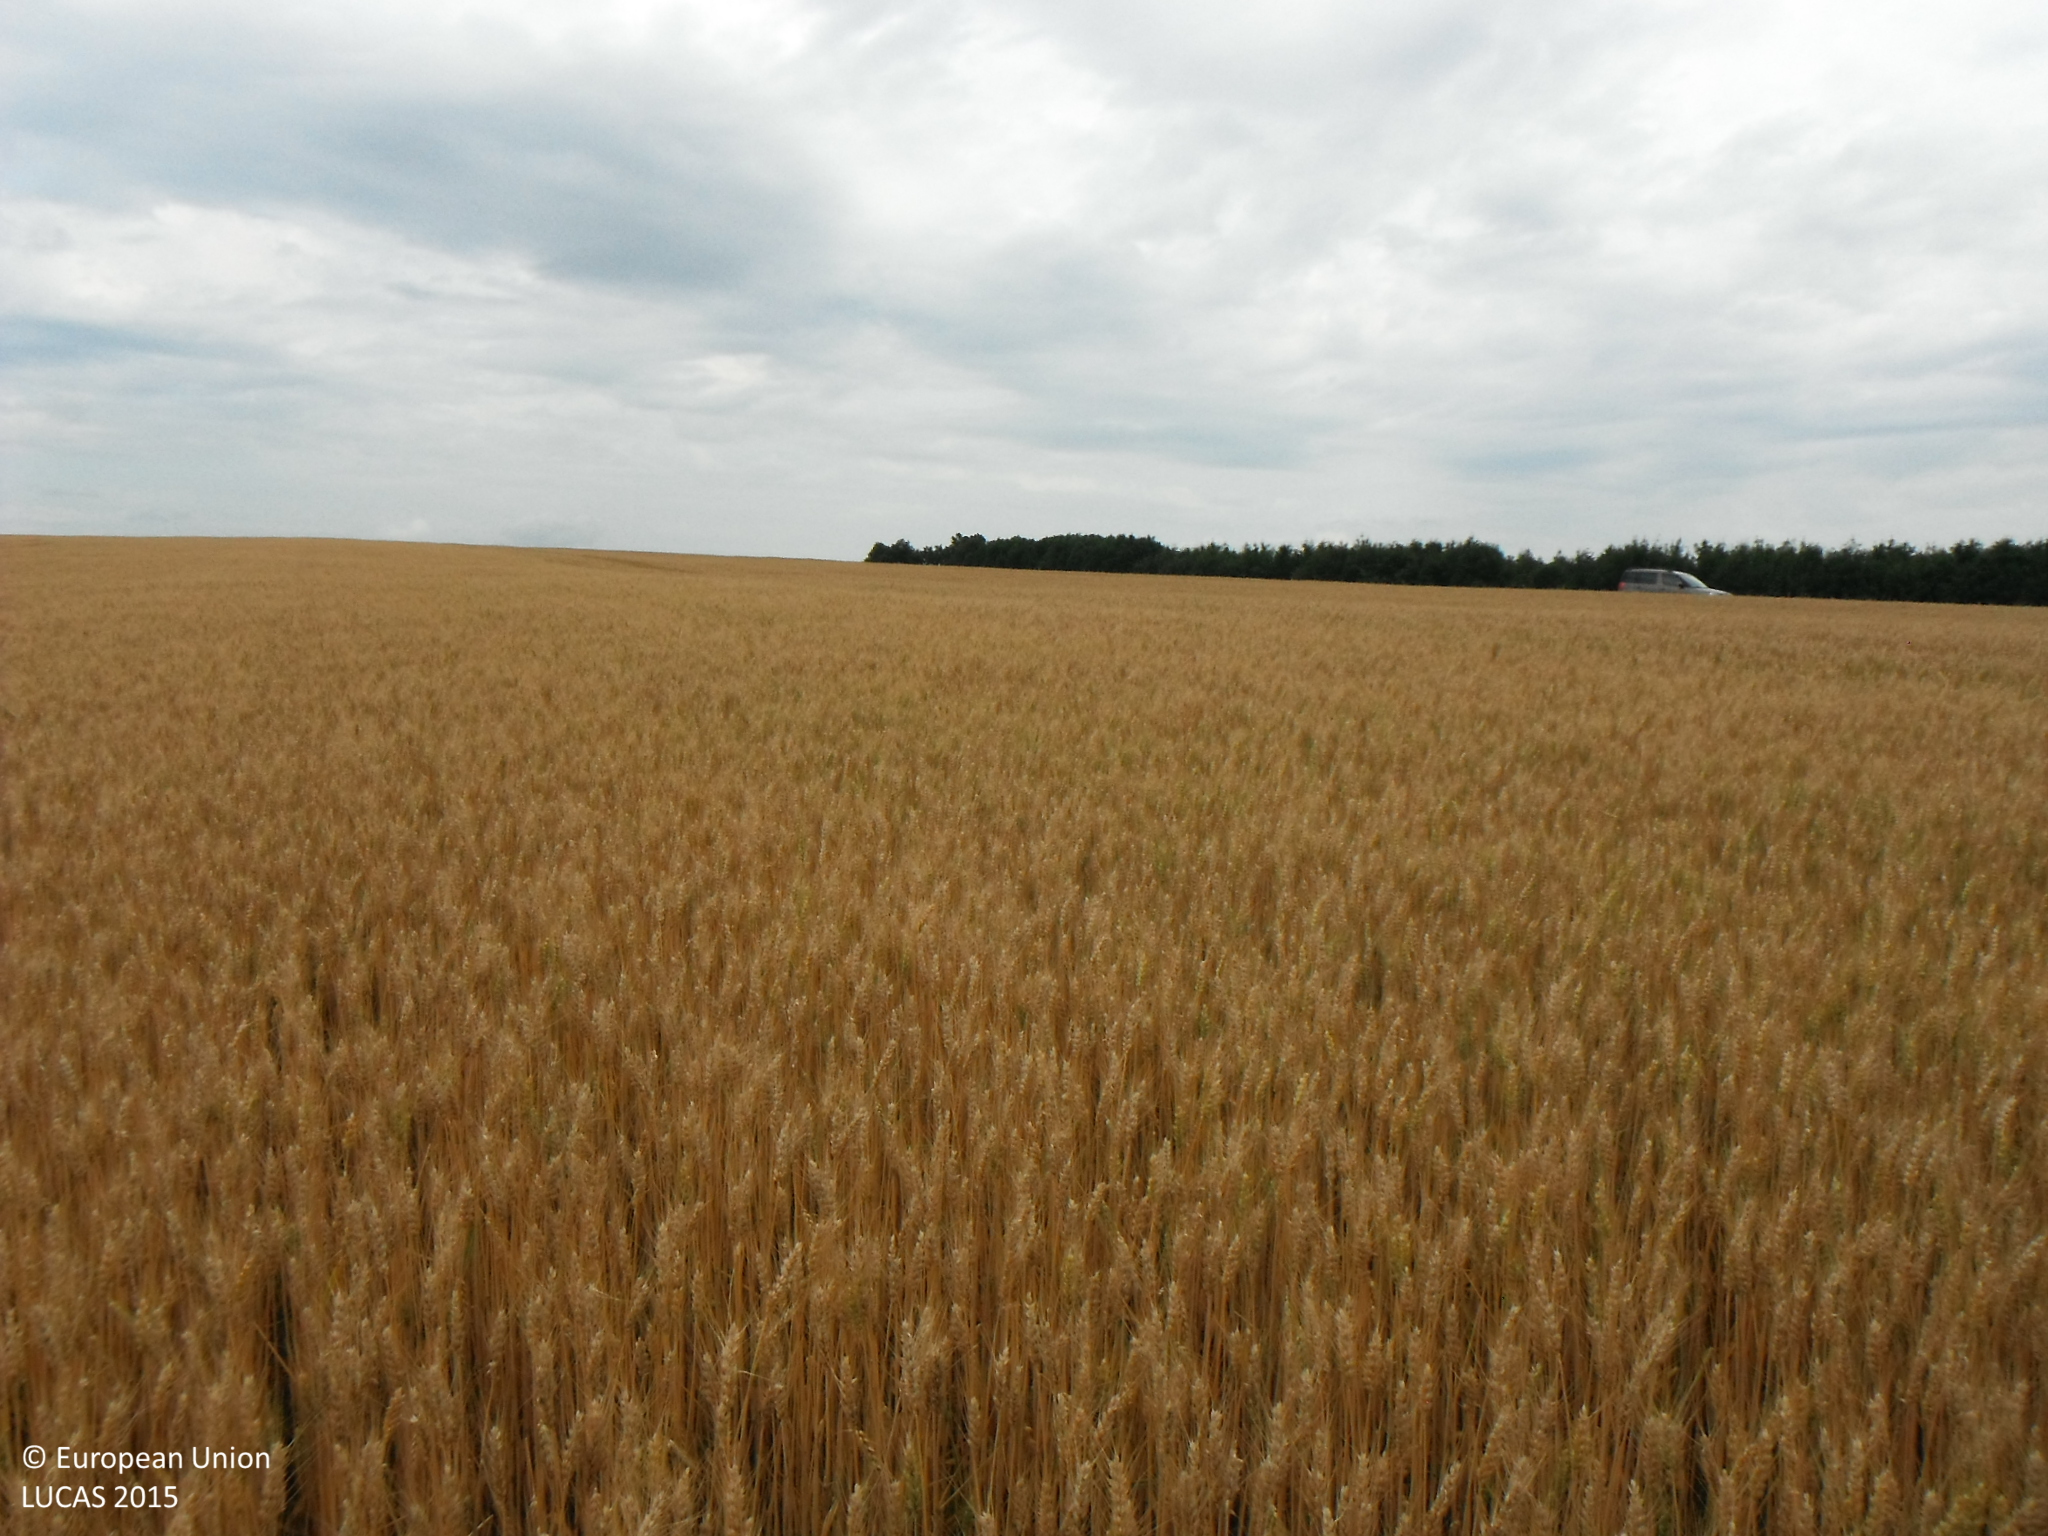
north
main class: Cropland
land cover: Common wheat
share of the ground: > 75 %
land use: Agriculture (excluding fallow land and kitchen gardens)
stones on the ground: 10 - 25 %
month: July
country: SK
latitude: 48.7289
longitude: 21.3156
